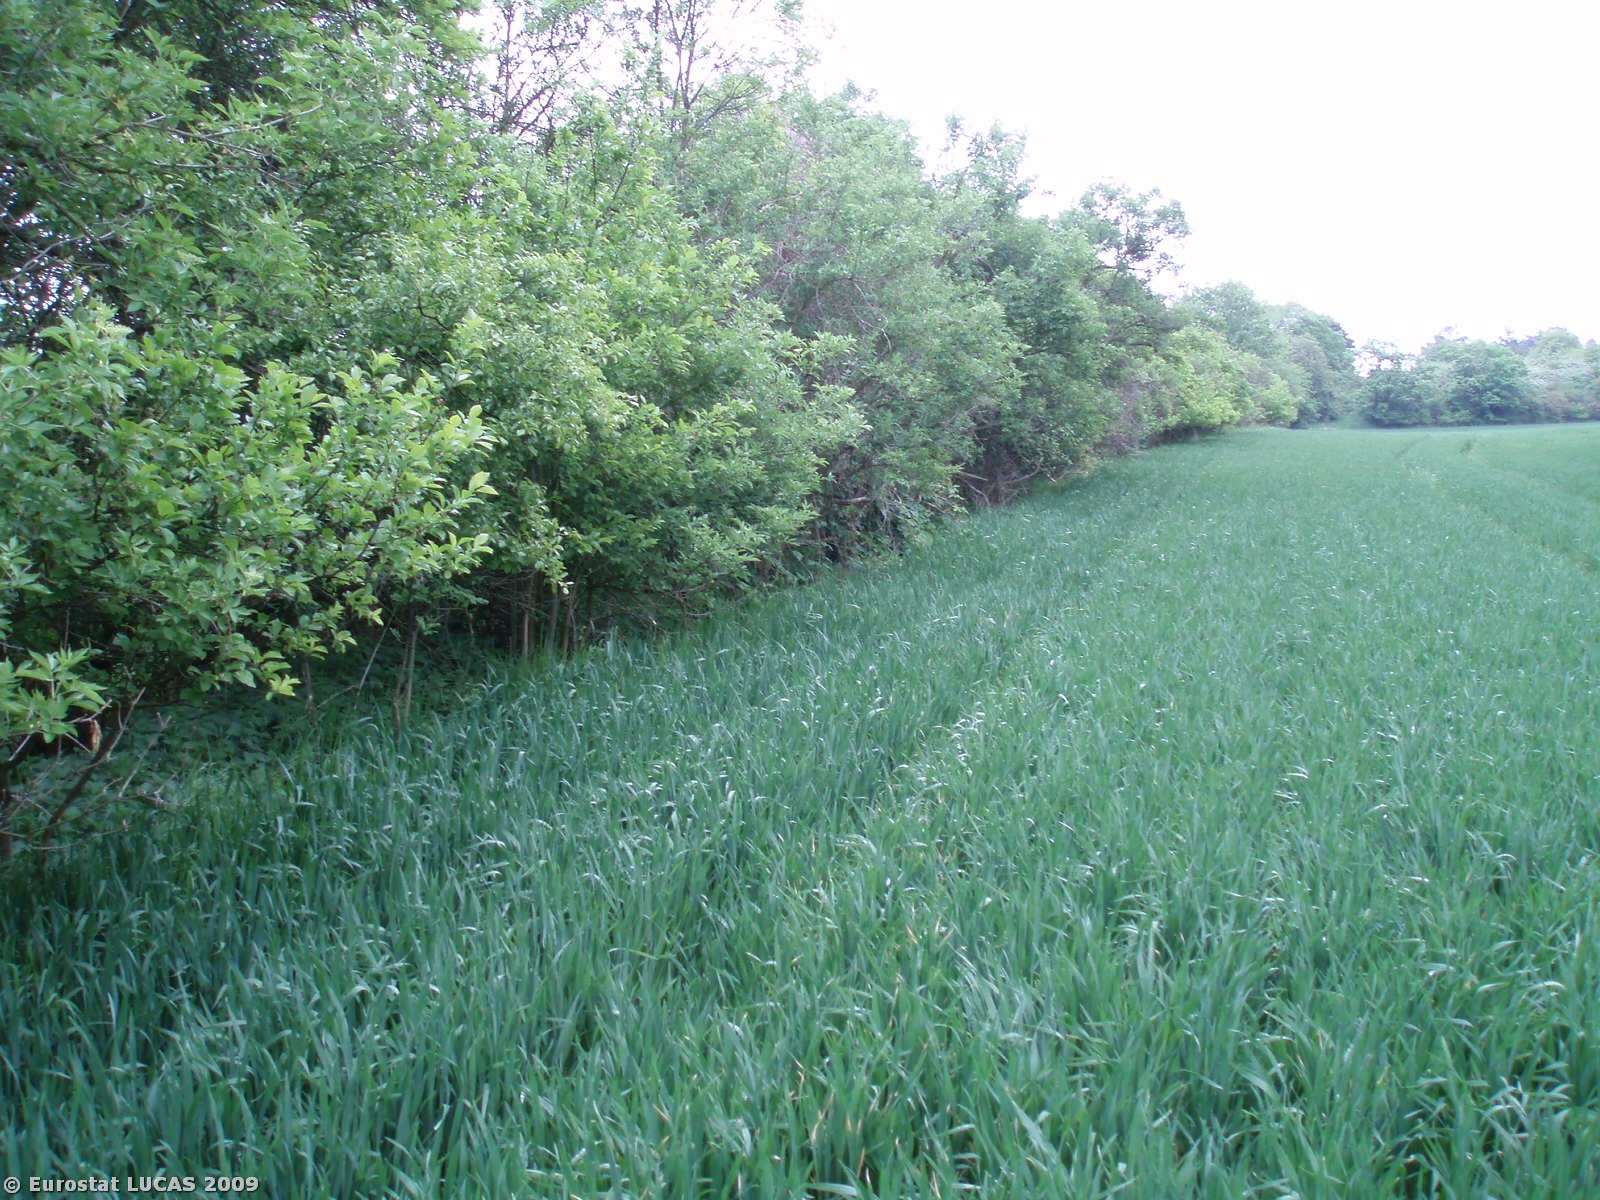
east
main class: Woodland
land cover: Broadleaved woodland
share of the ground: > 75 %
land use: Unused
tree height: > 5 m
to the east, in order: Broadleaved woodland; Common wheat
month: May
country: CZ
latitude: 50.2163
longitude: 14.1634
